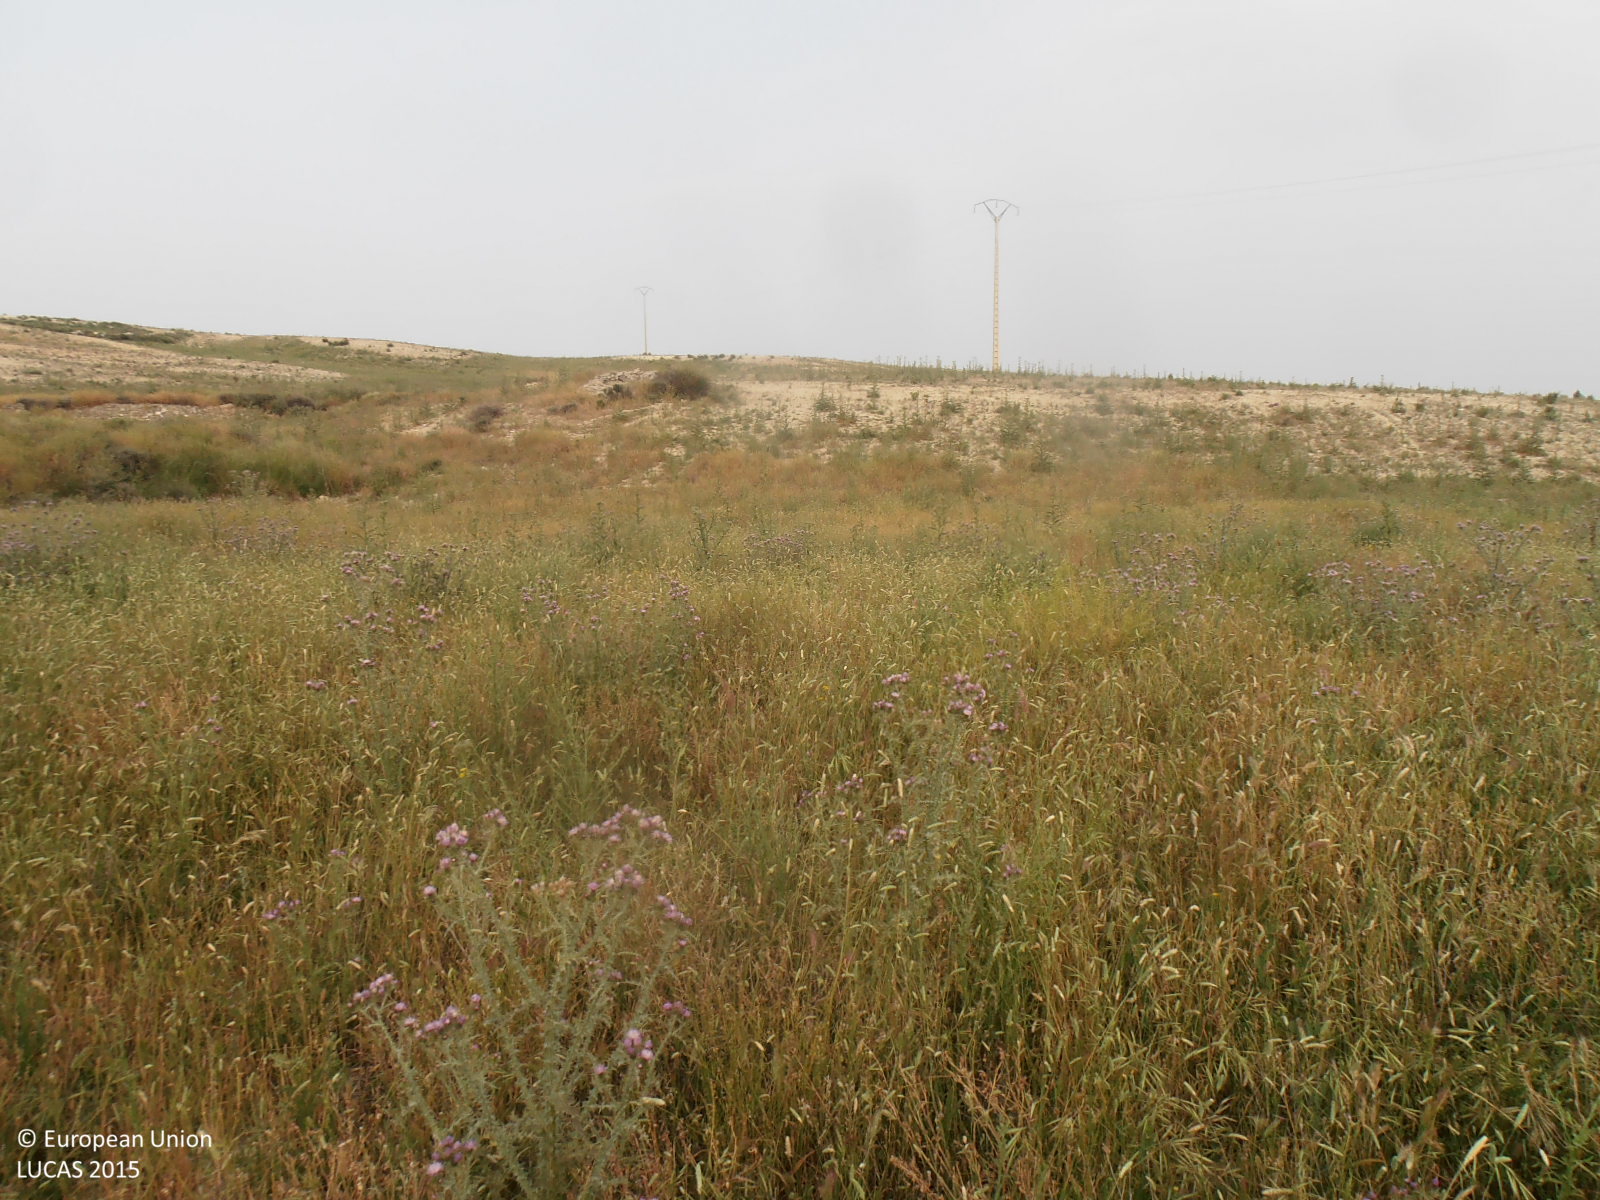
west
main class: Grassland
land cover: Spontaneously vegetated surfaces
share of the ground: > 75 %
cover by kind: herbaceous plants 100 %
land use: Fallow land
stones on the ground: < 10 %
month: May
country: ES
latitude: 41.6103
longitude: -1.0506
